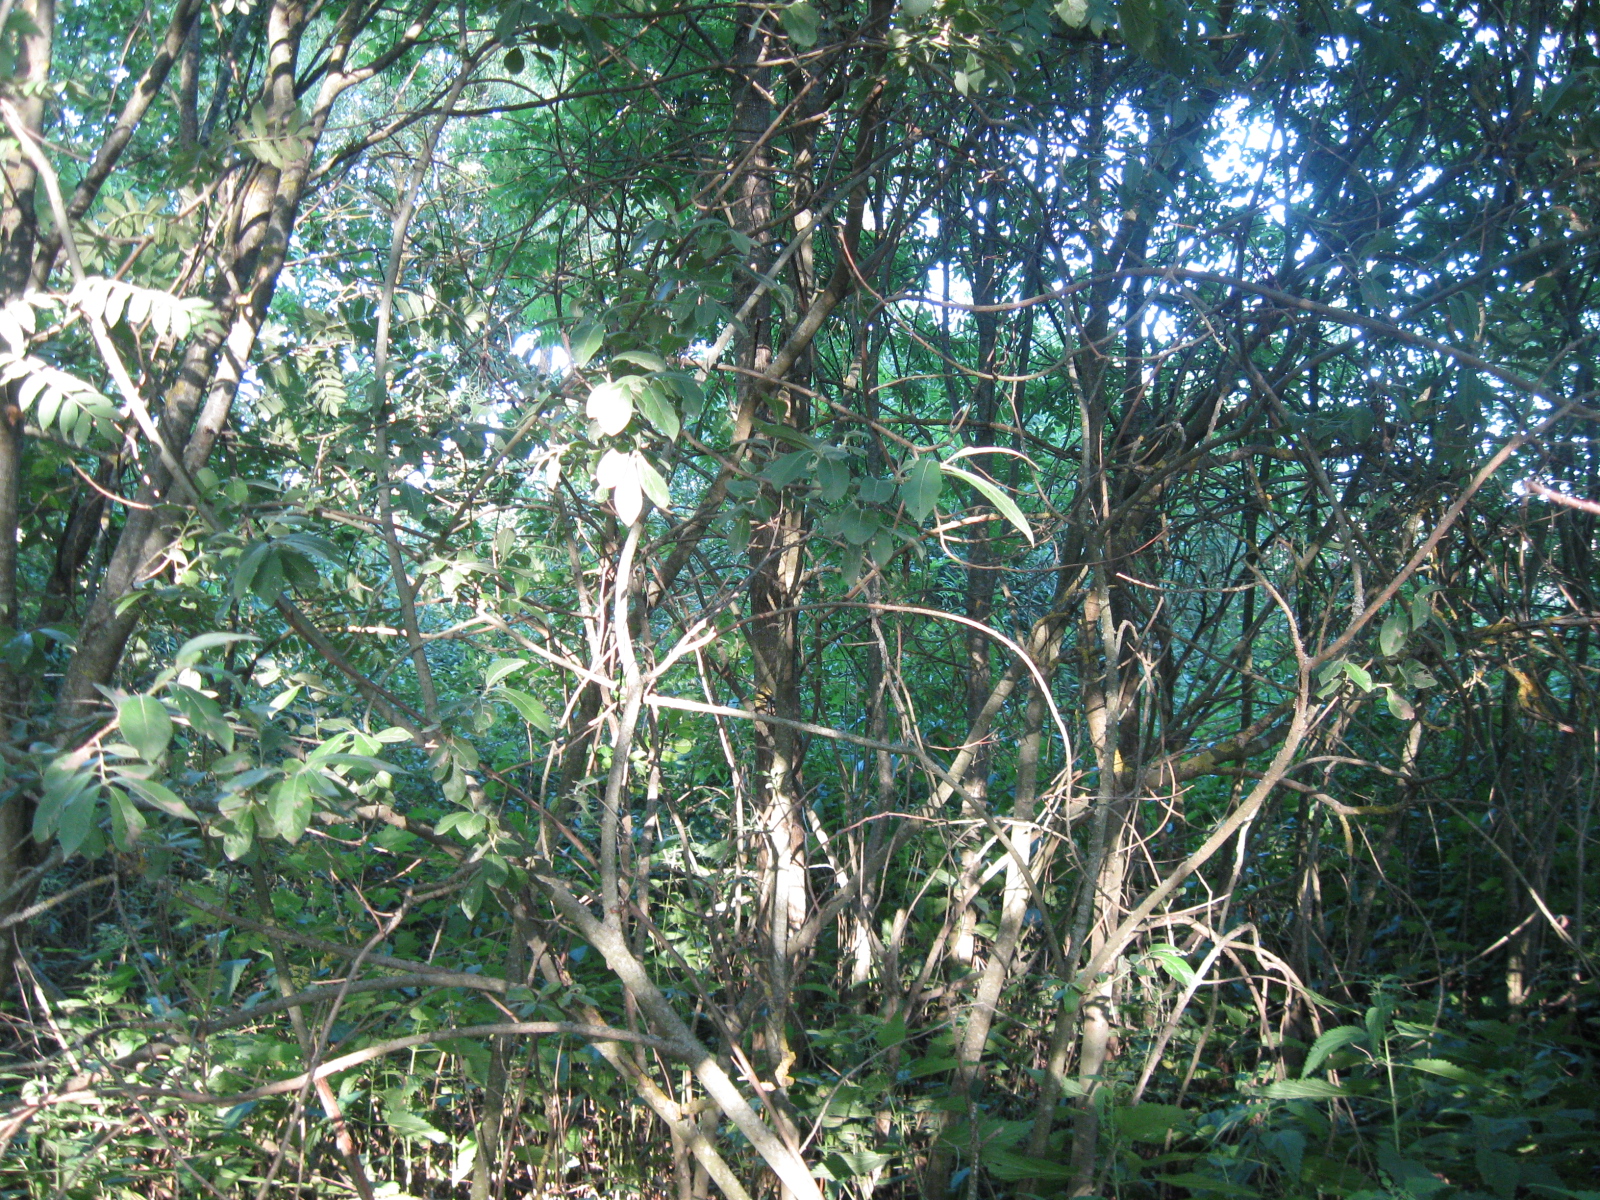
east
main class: Woodland
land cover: Broadleaved woodland
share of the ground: > 75 %
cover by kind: broadleaved forest trees 80 %, herbaceous plants 20 %
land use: Semi-natural and natural areas not in use
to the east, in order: Broadleaved woodland; Common wheat; Pine dominated coniferous woodland
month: July
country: LT
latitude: 54.3338
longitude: 23.5397
